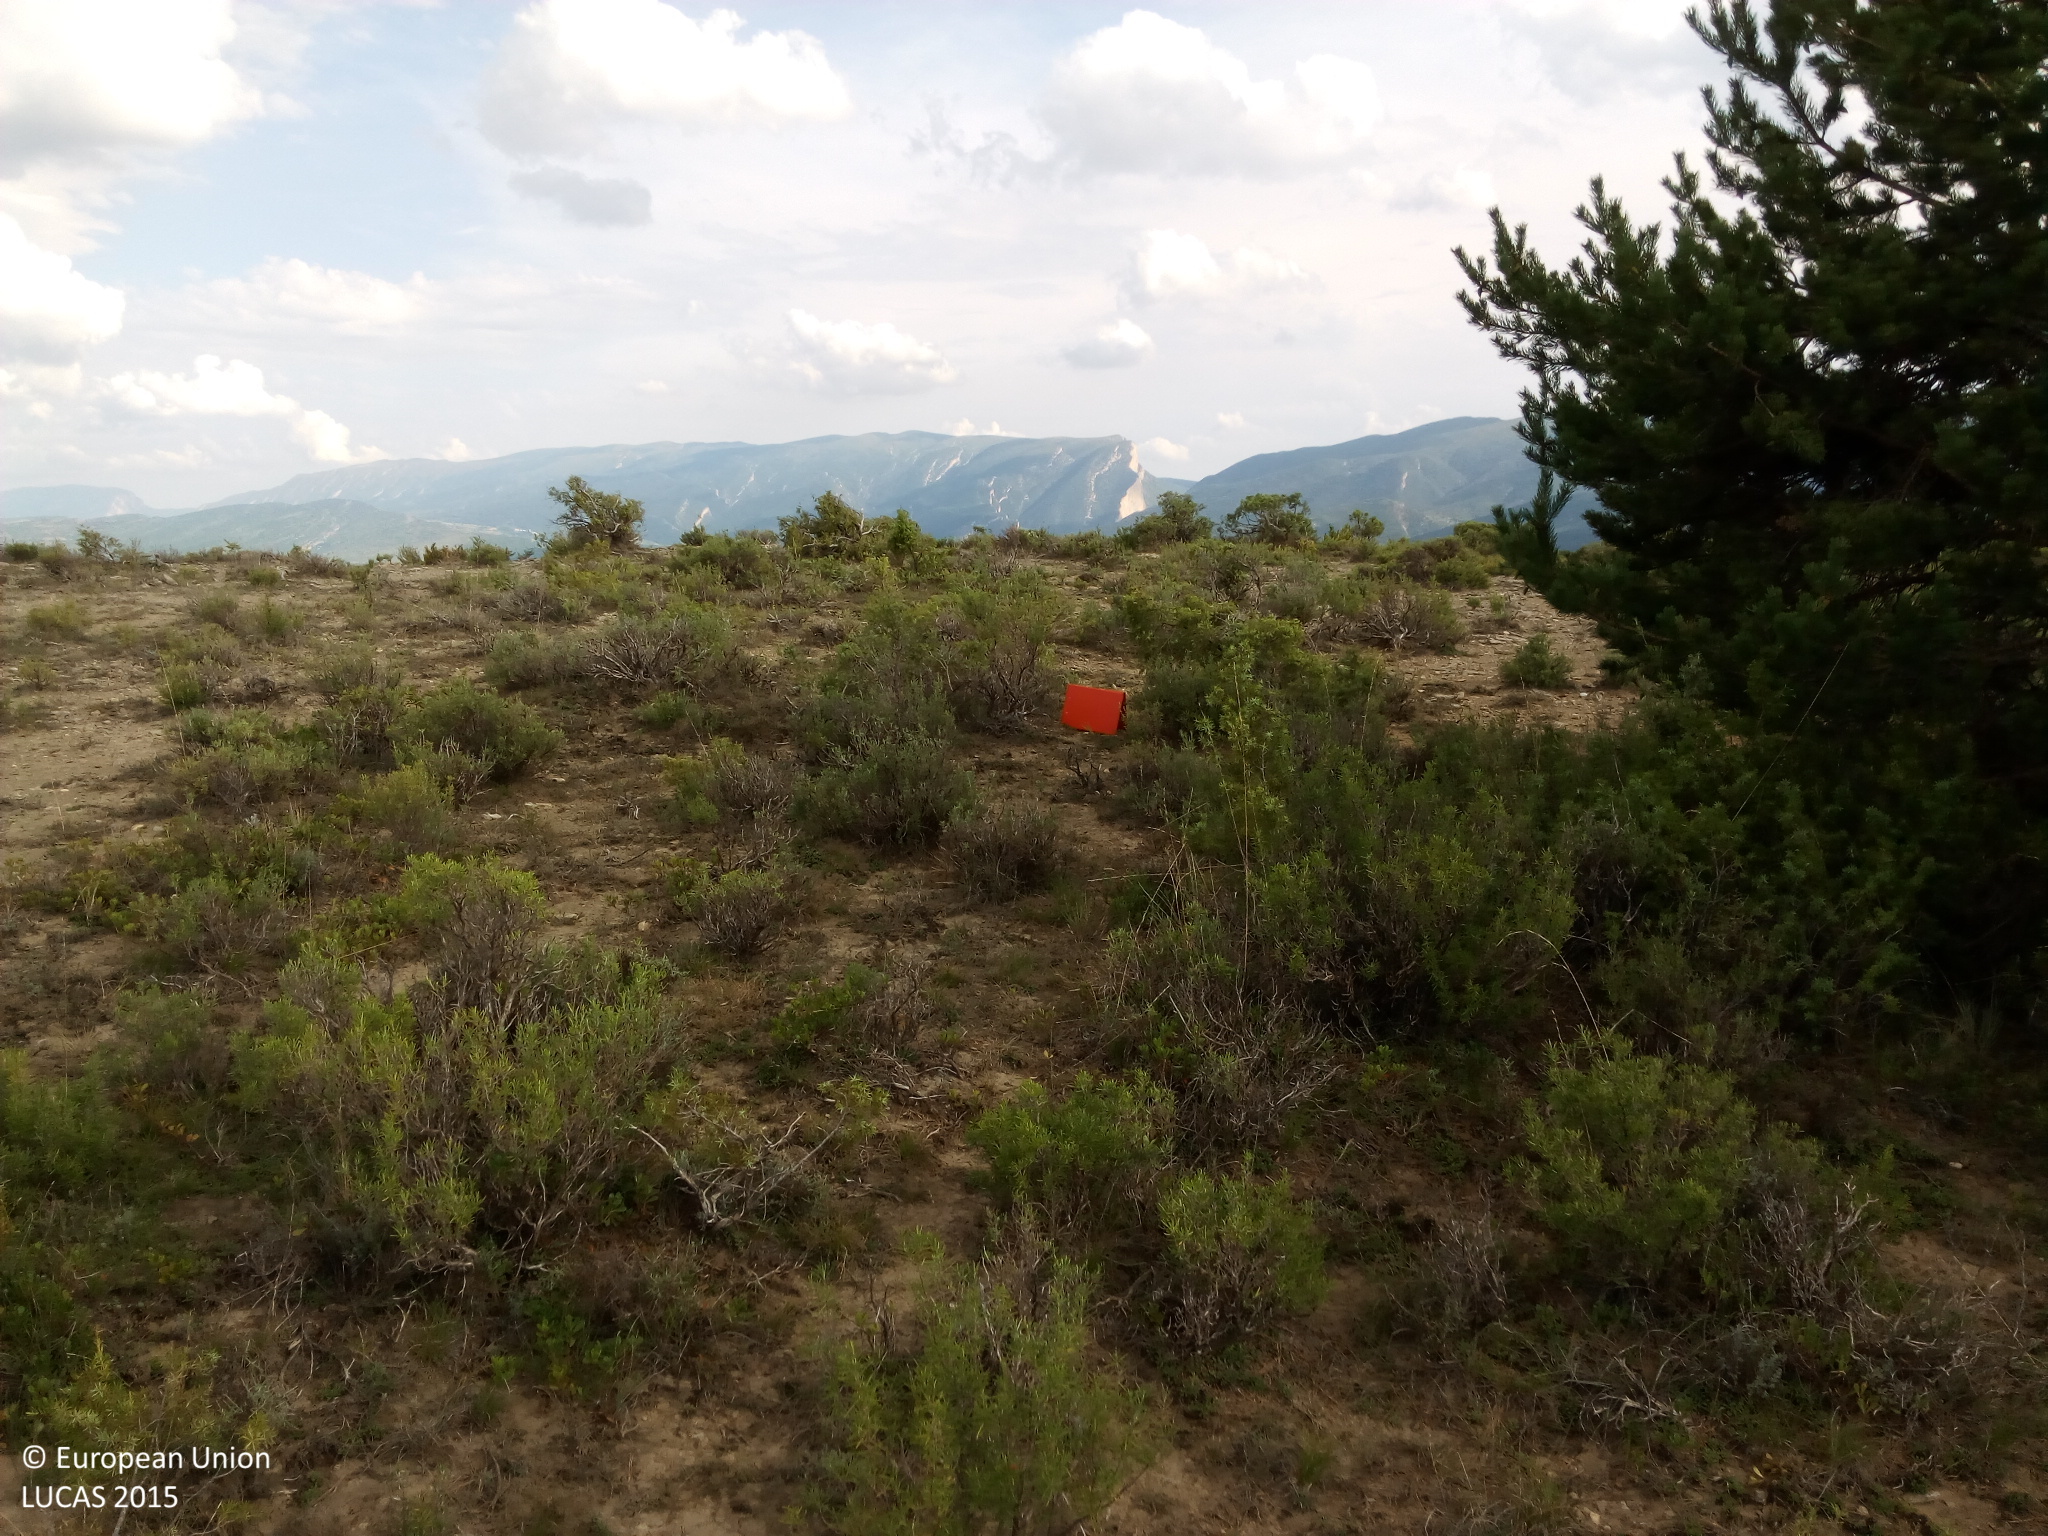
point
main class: Shrubland
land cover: Shrubland with sparse tree cover
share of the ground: > 75 %
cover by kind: shrubs 45 %, herbaceous plants 20 %, unconsolidated bare surface 20 %, consolidated bare surface 10 %, broadleaved forest trees 5 %
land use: Semi-natural and natural areas not in use
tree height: < 5 m
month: August
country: ES
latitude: 42.1461
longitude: 0.6299
